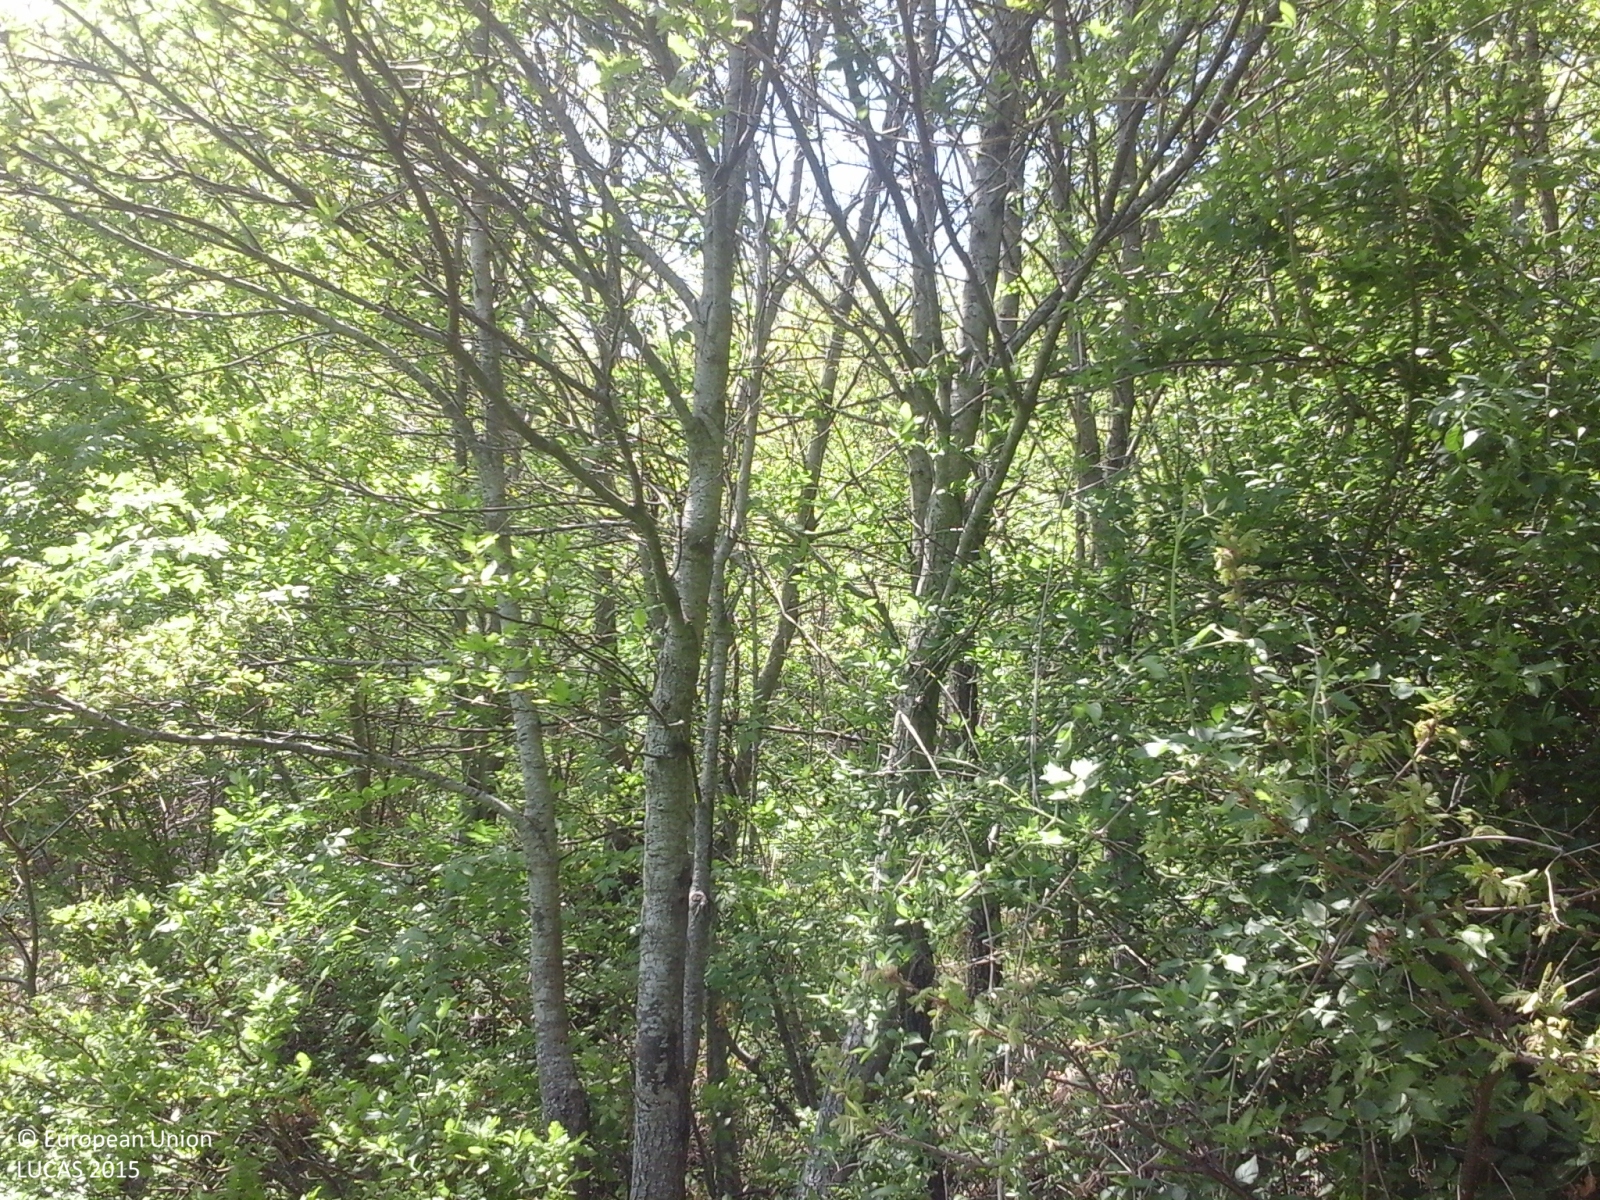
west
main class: Woodland
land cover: Broadleaved woodland
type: thermophilous deciduous forest
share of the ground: > 75 %
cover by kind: broadleaved forest trees 100 %
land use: Forestry
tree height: > 5 m
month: May
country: IT
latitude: 41.3164
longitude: 14.6537
